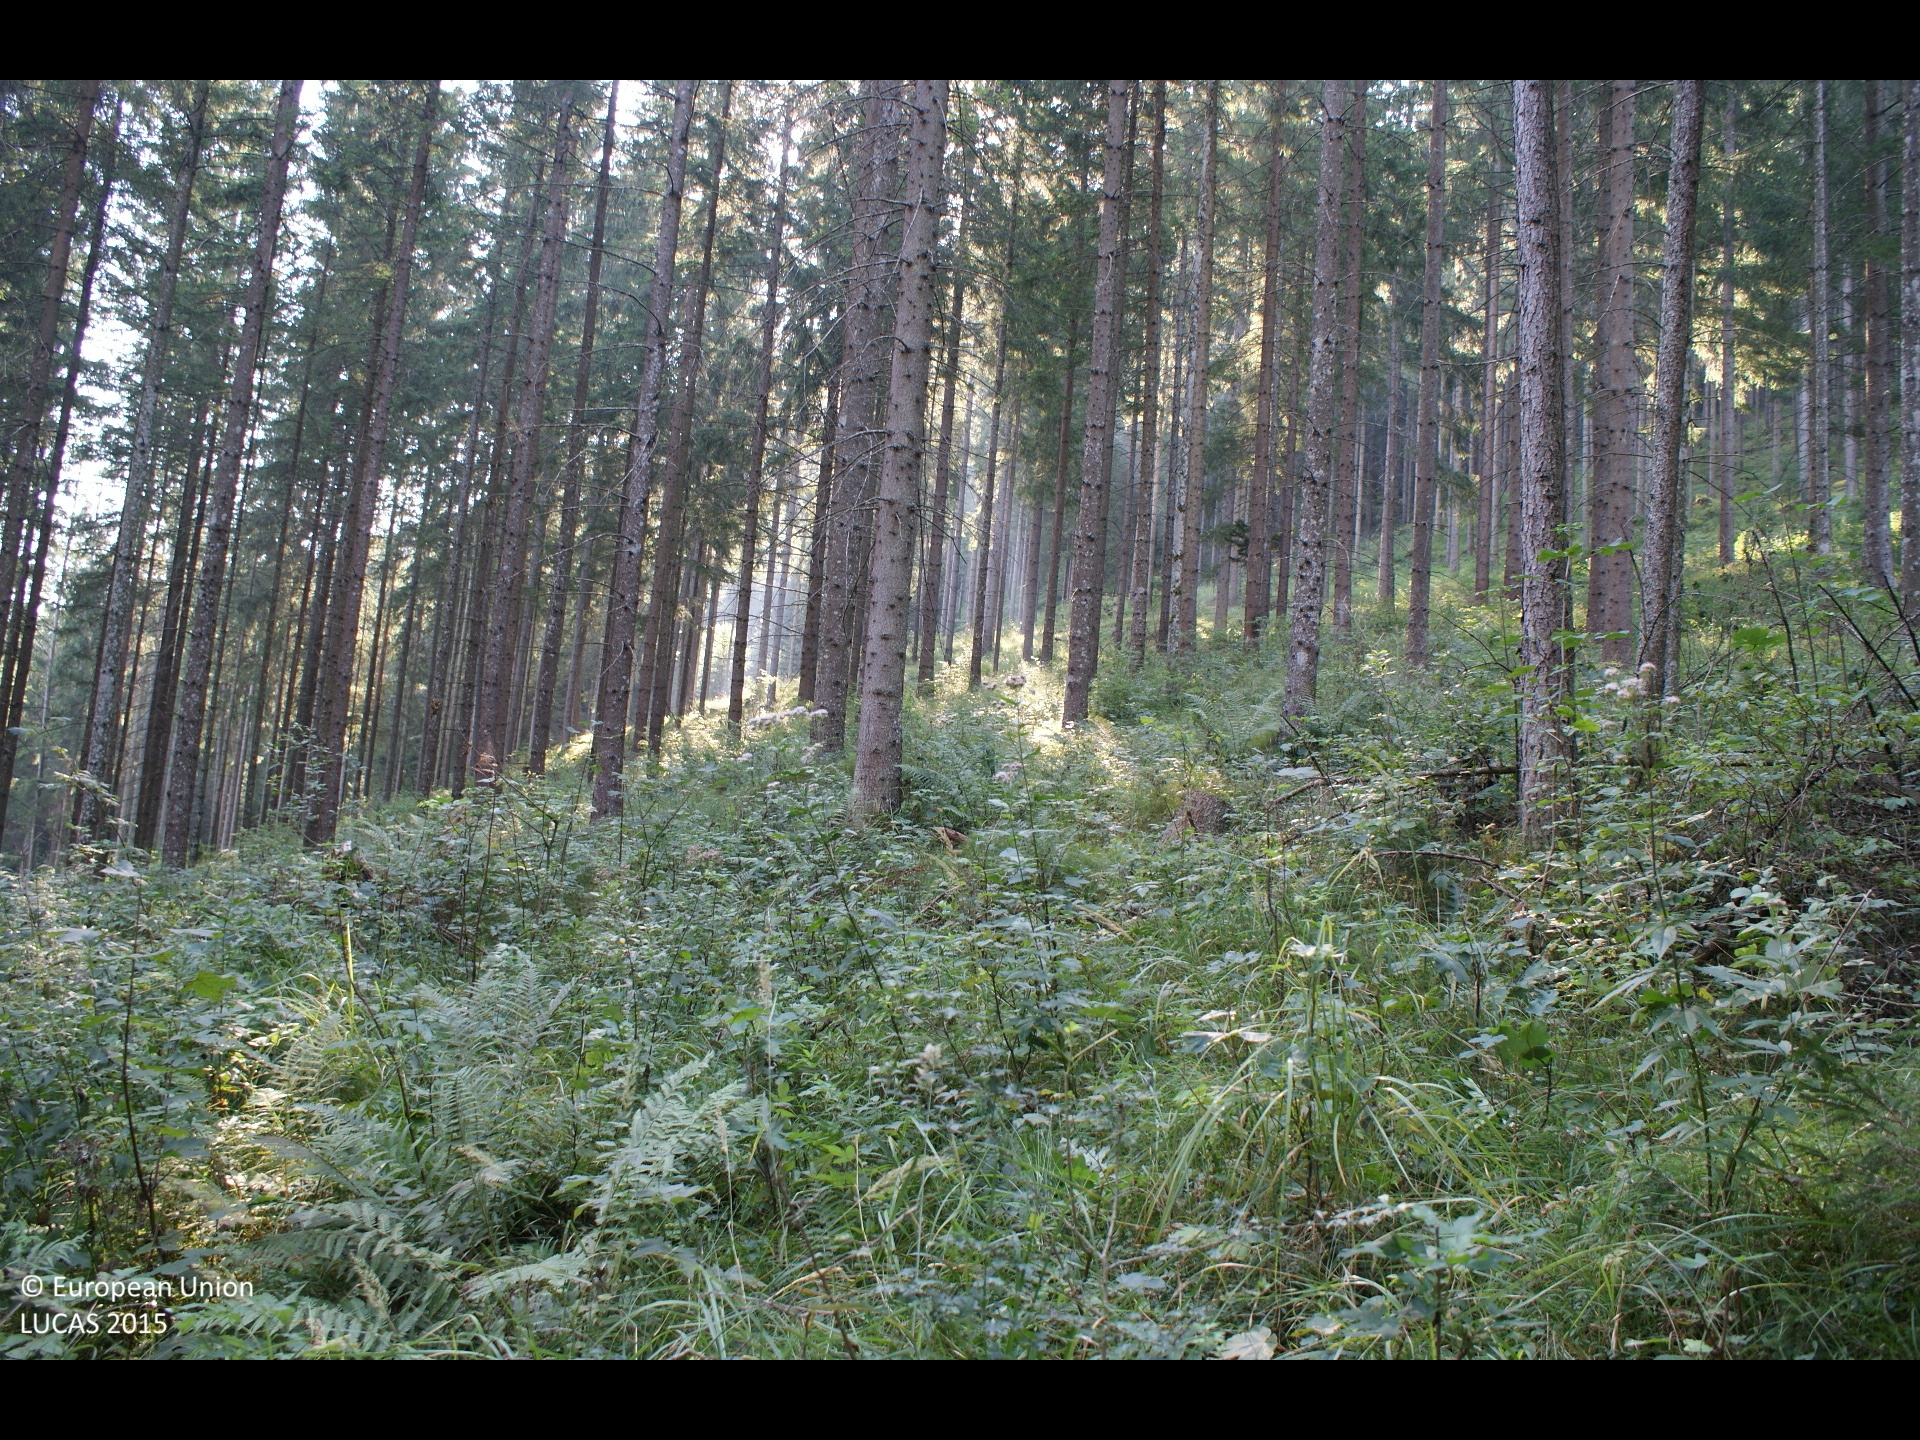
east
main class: Woodland
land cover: Spruce dominated coniferous woodland
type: alpine coniferous forest
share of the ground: 50 - 75 %
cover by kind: coniferous forest trees 50 %, shrubs 30 %, herbaceous plants 20 %
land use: Forestry
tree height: > 5 m
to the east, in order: Spruce dominated coniferous woodland; Tracks; Spruce dominated coniferous woodland
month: August
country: AT
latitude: 47.5369
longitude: 15.3011
